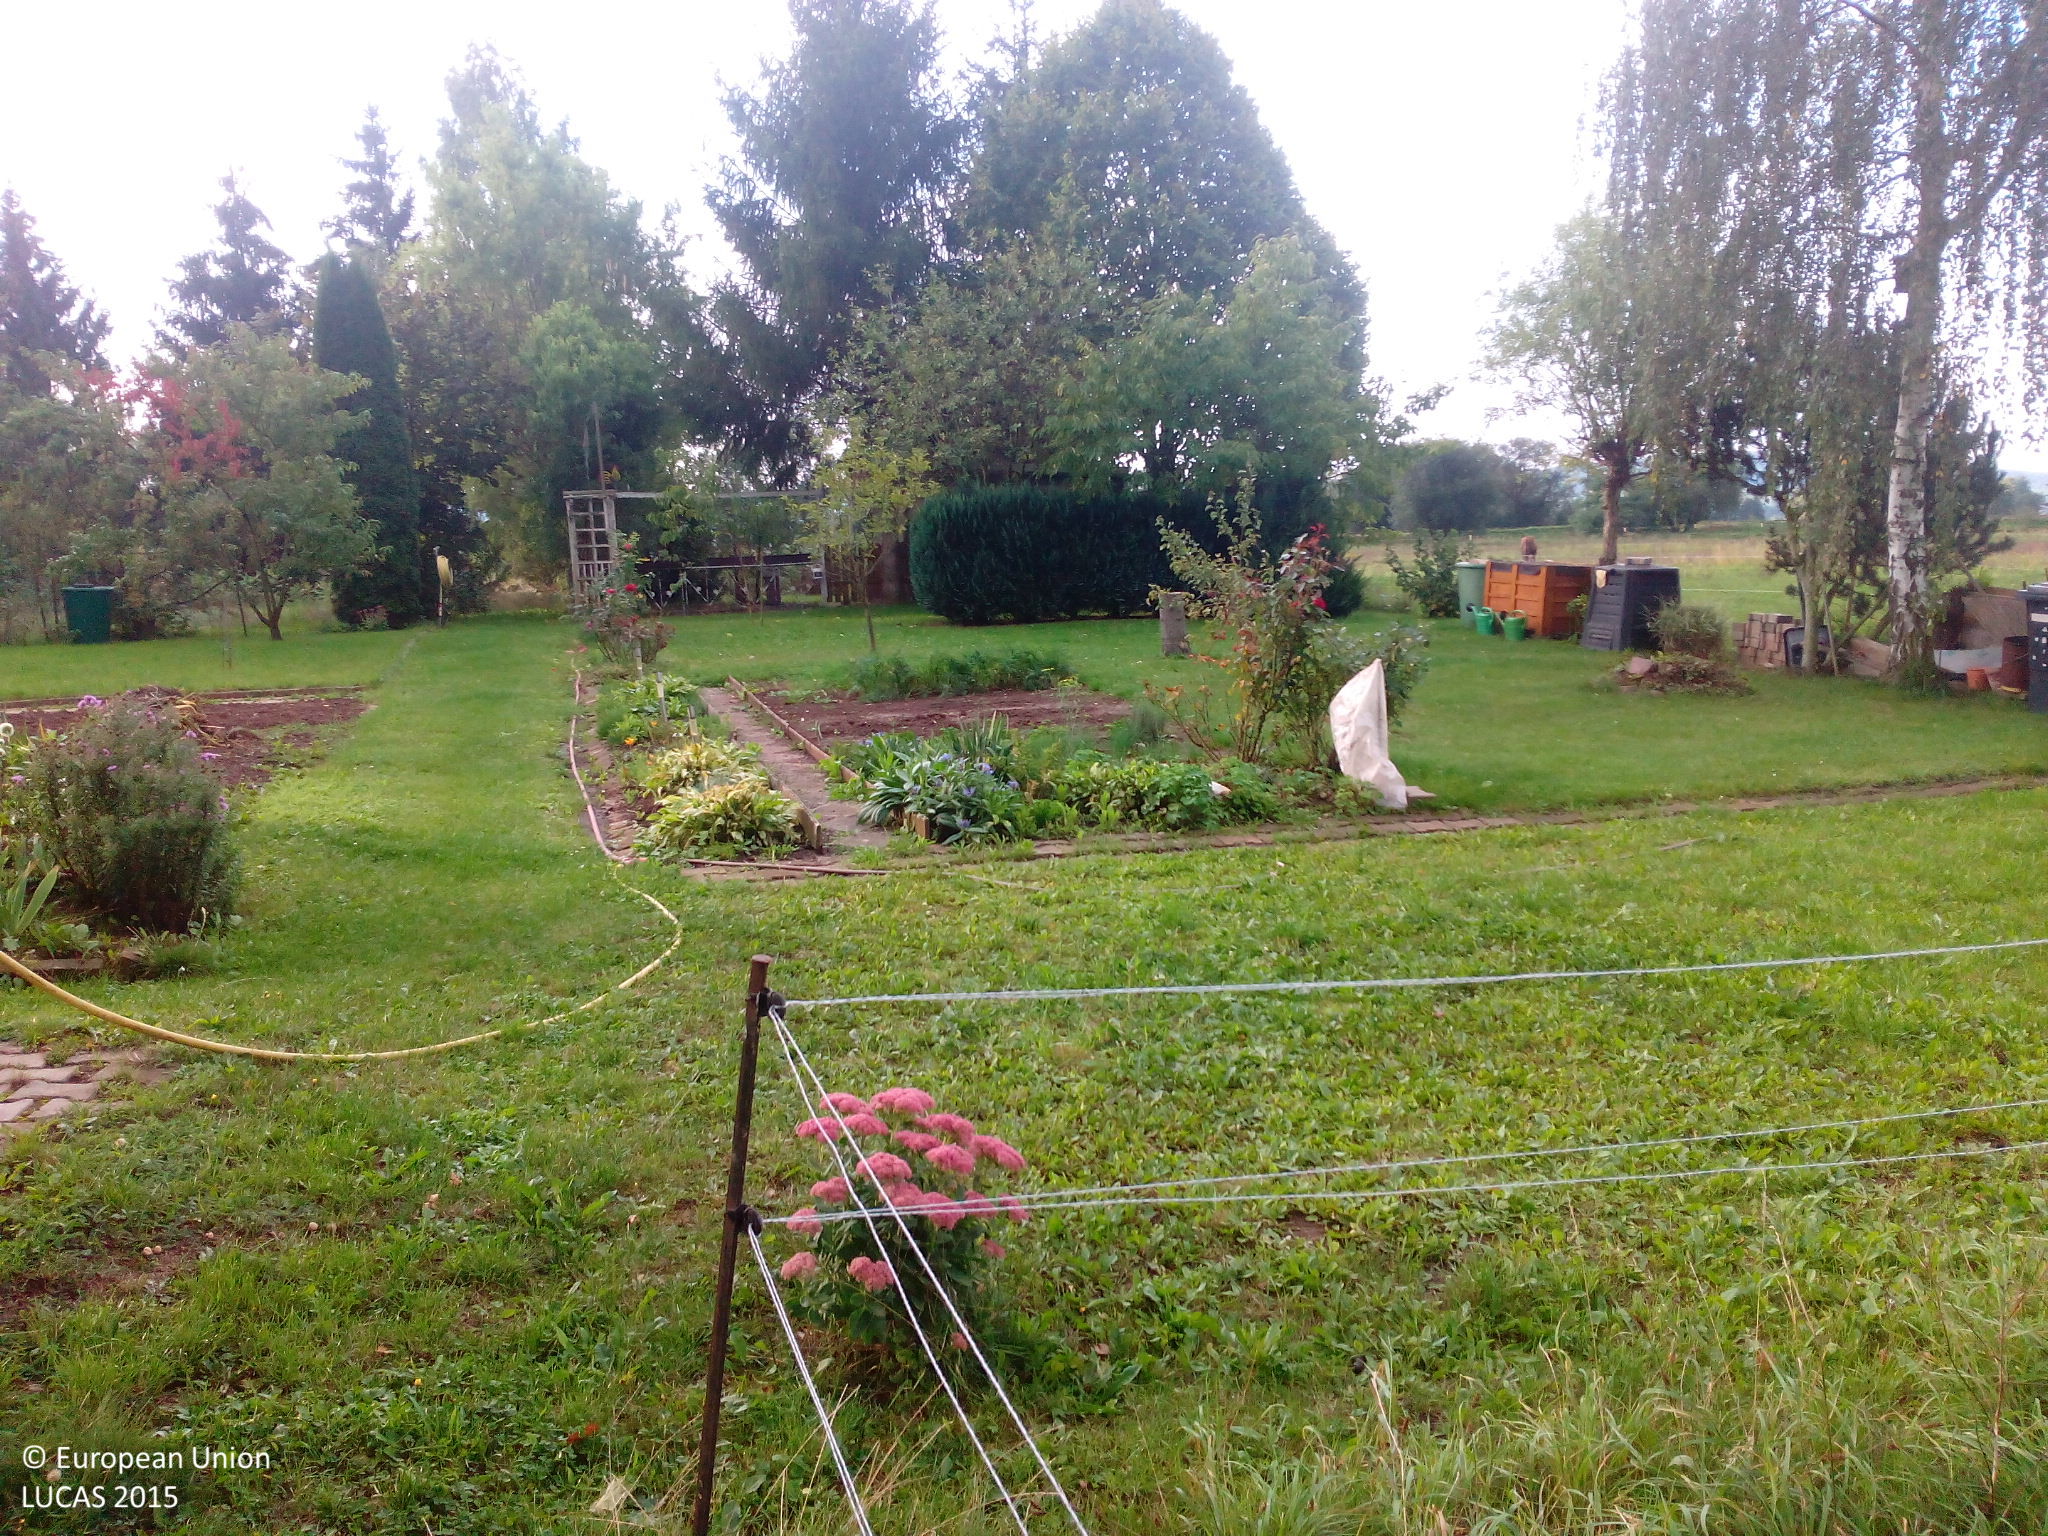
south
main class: Grassland
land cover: Grassland without tree/shrub cover
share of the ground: > 75 %
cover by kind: herbaceous plants 100 %
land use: Agriculture (excluding fallow land and kitchen gardens)
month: September
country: DE
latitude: 51.4570
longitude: 10.9352
